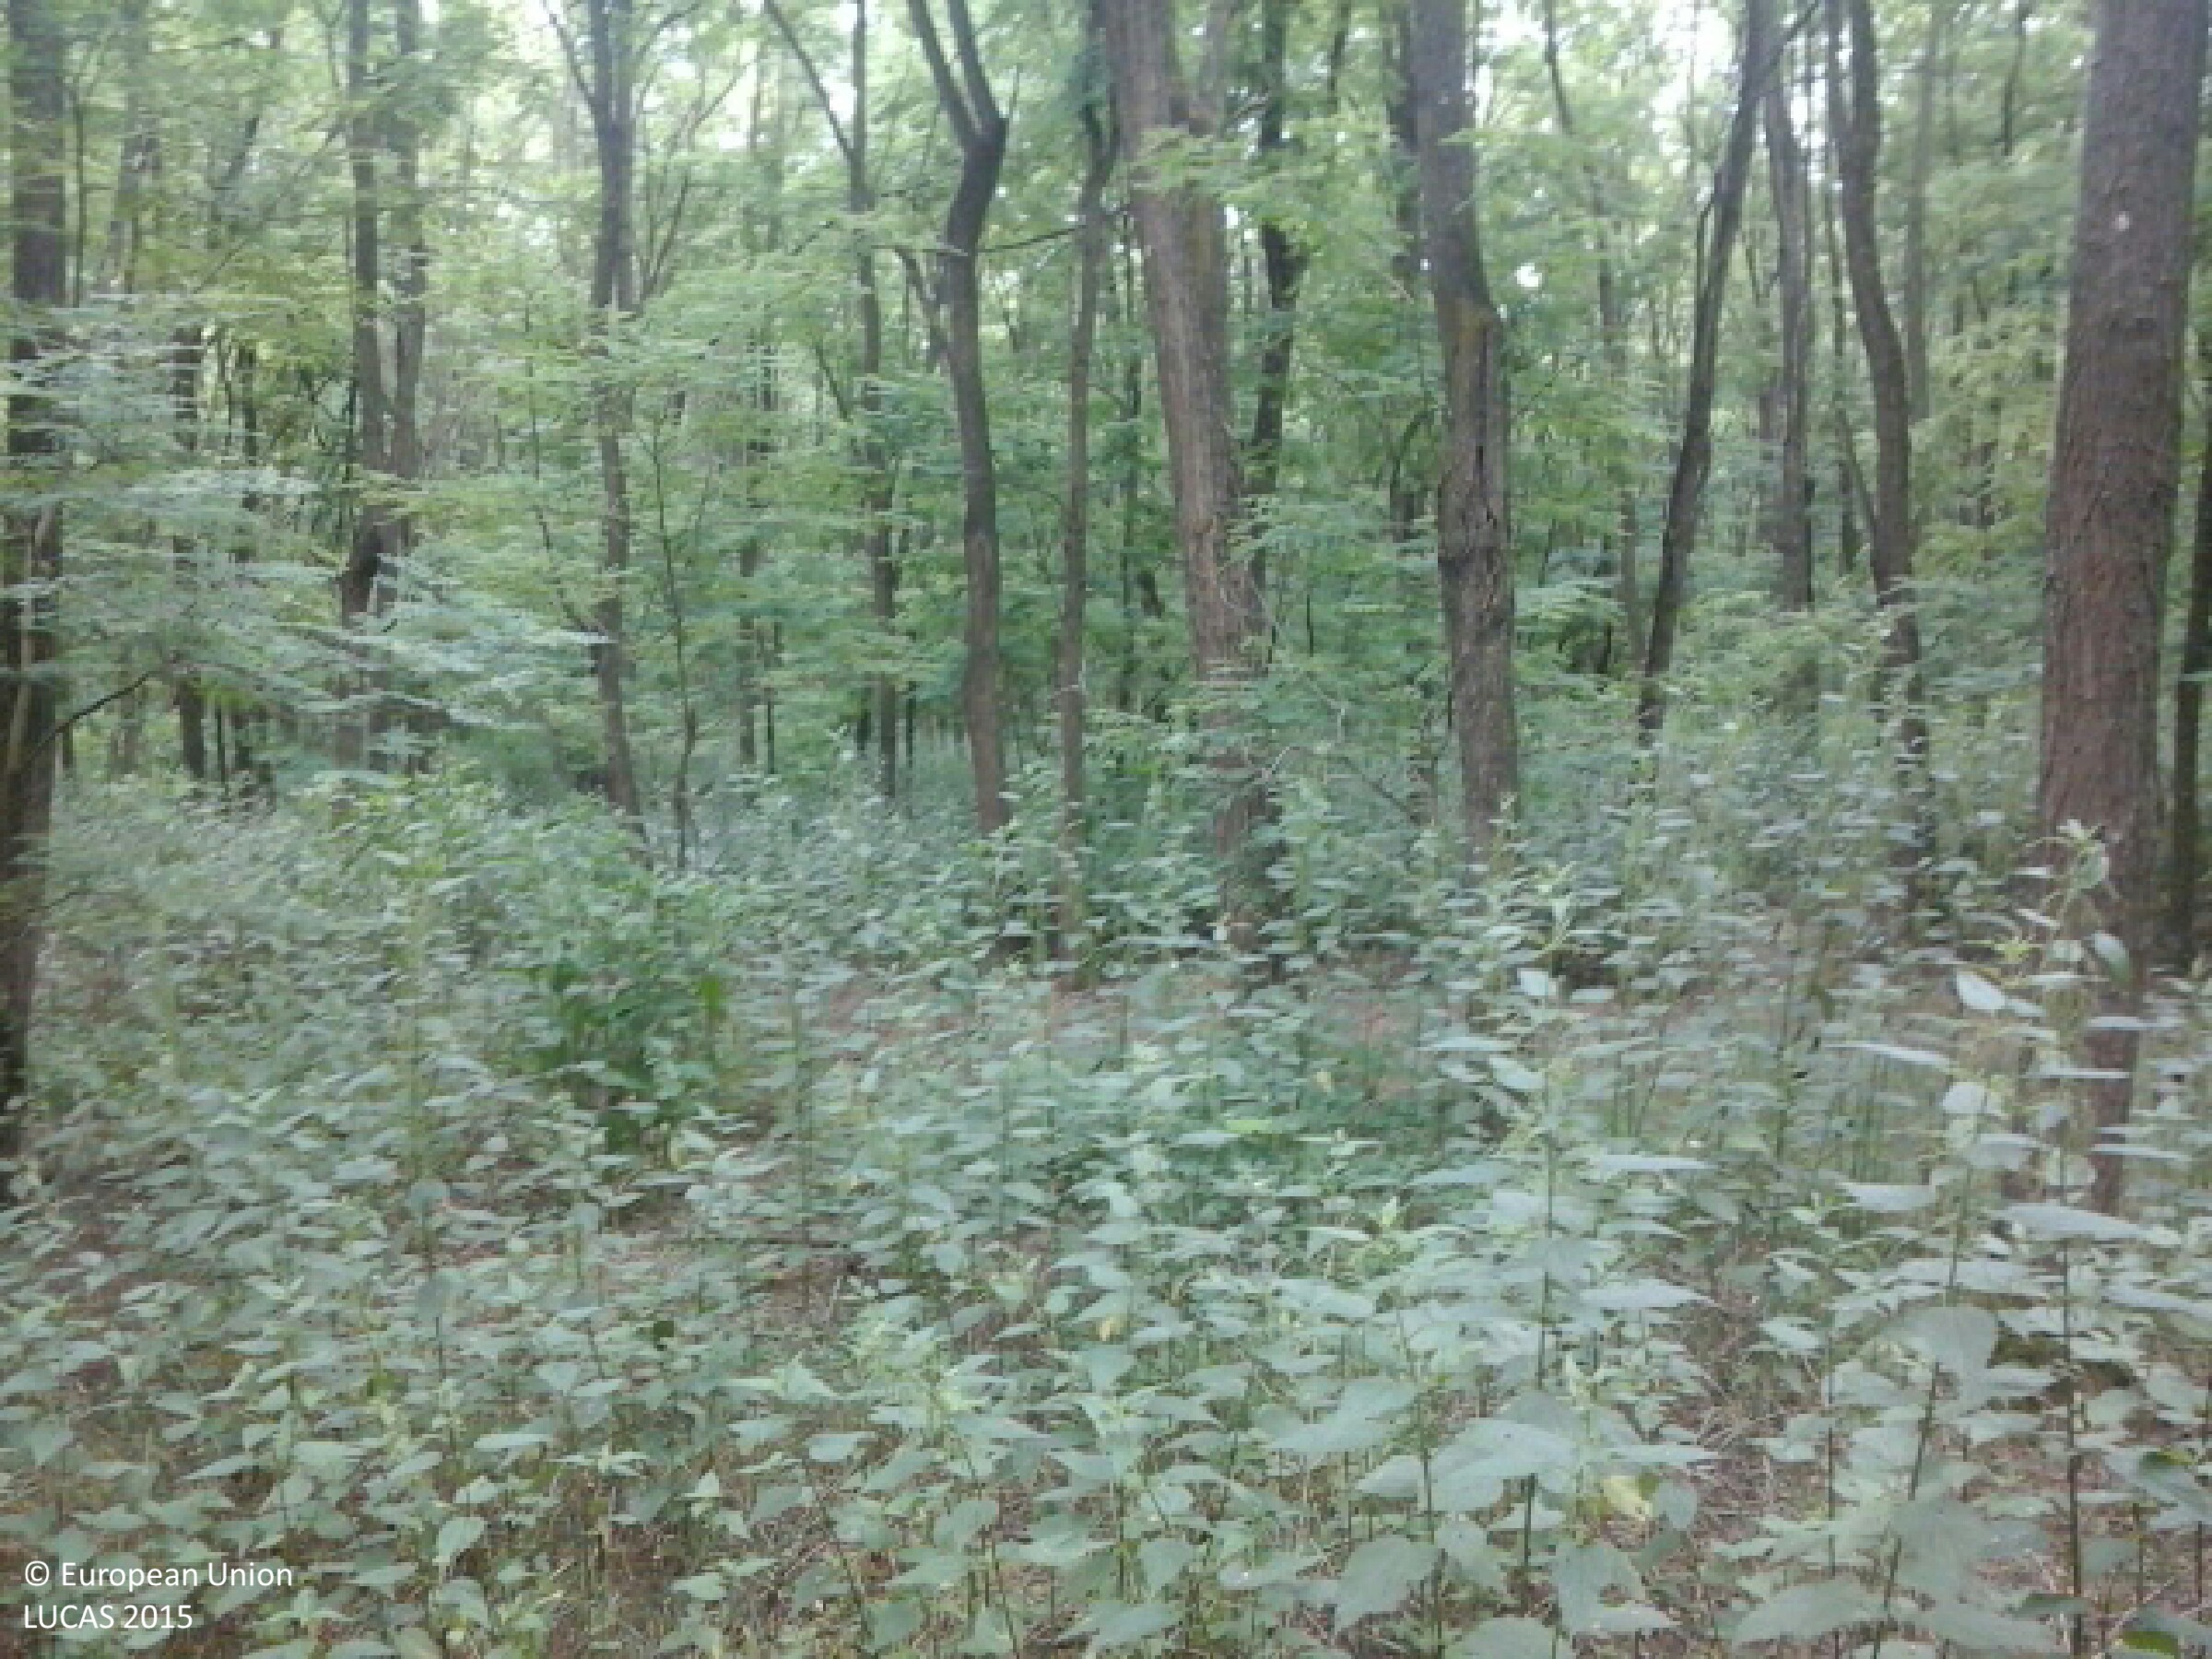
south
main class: Woodland
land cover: Broadleaved woodland
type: mesophytic deciduous forest
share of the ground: > 75 %
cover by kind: broadleaved forest trees 95 %, herbaceous plants 5 %
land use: Forestry
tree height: > 5 m
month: June
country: HU
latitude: 47.9731
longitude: 22.0960
